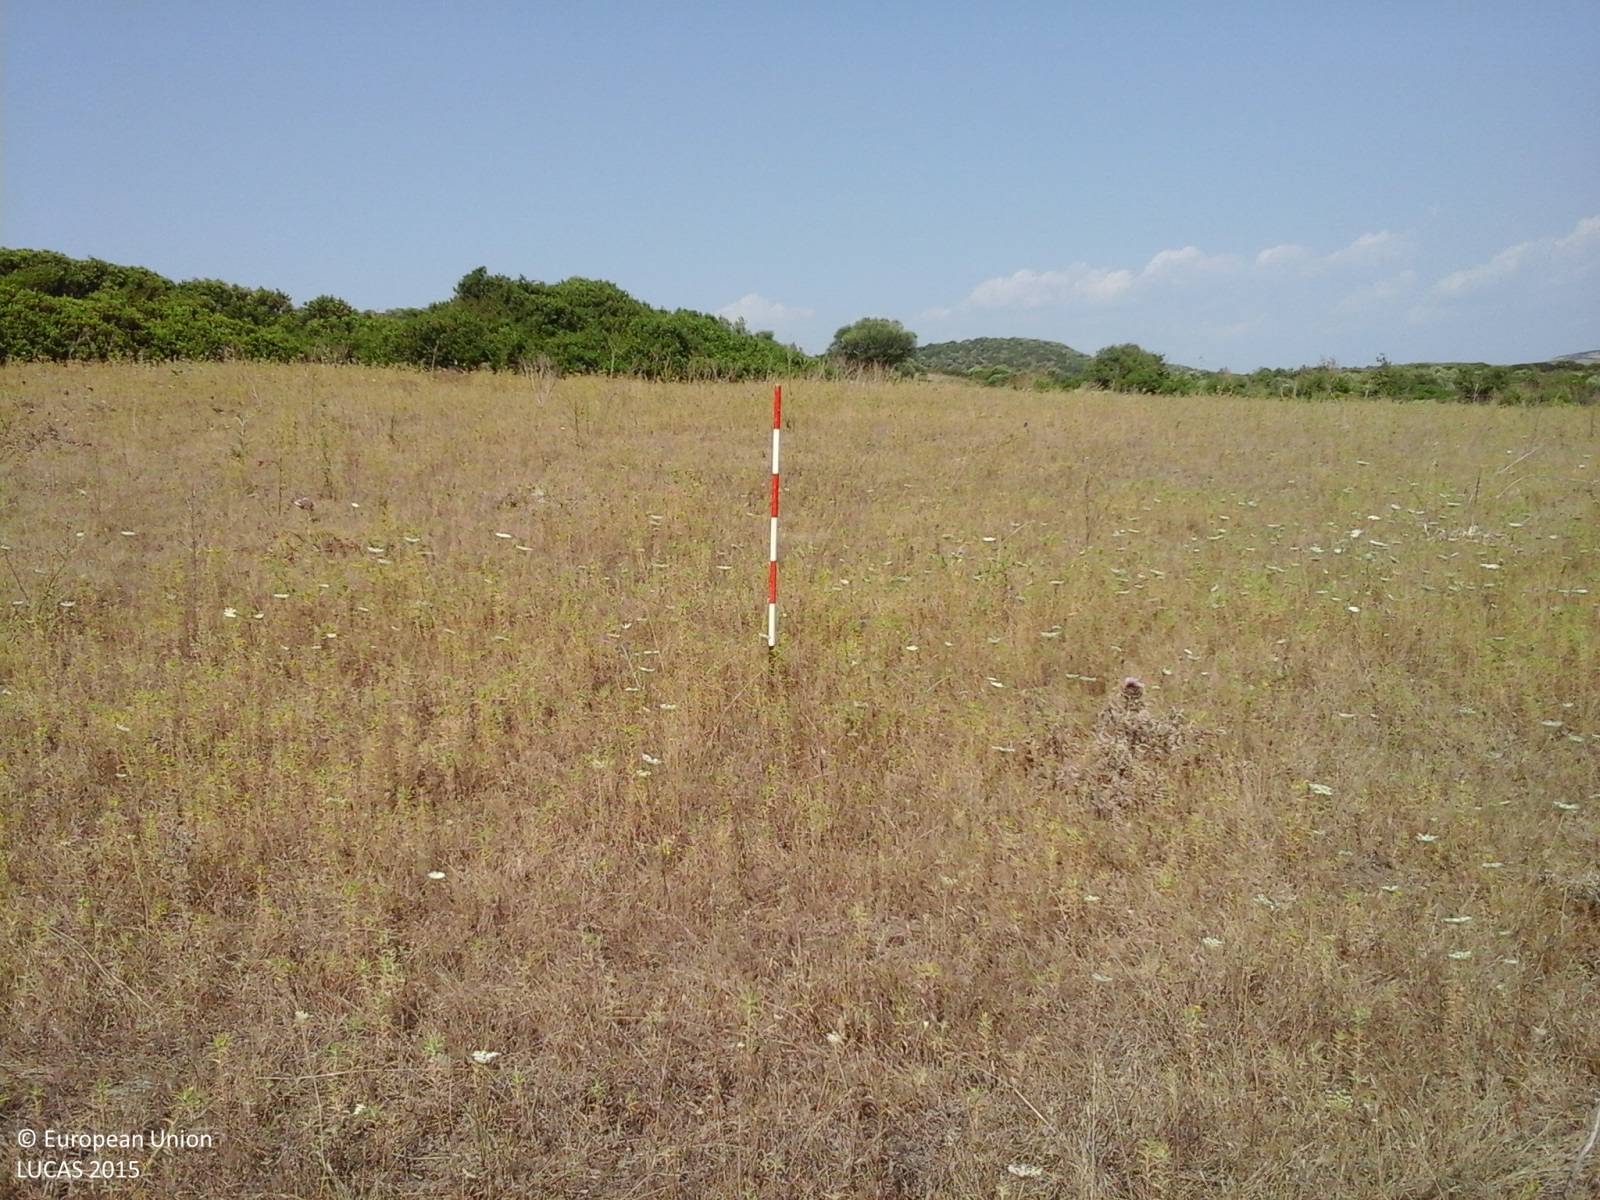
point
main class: Grassland
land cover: Grassland without tree/shrub cover
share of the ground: > 75 %
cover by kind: herbaceous plants 100 %
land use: Agriculture (excluding fallow land and kitchen gardens)
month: July
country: IT
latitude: 40.0065
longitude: 8.8000
